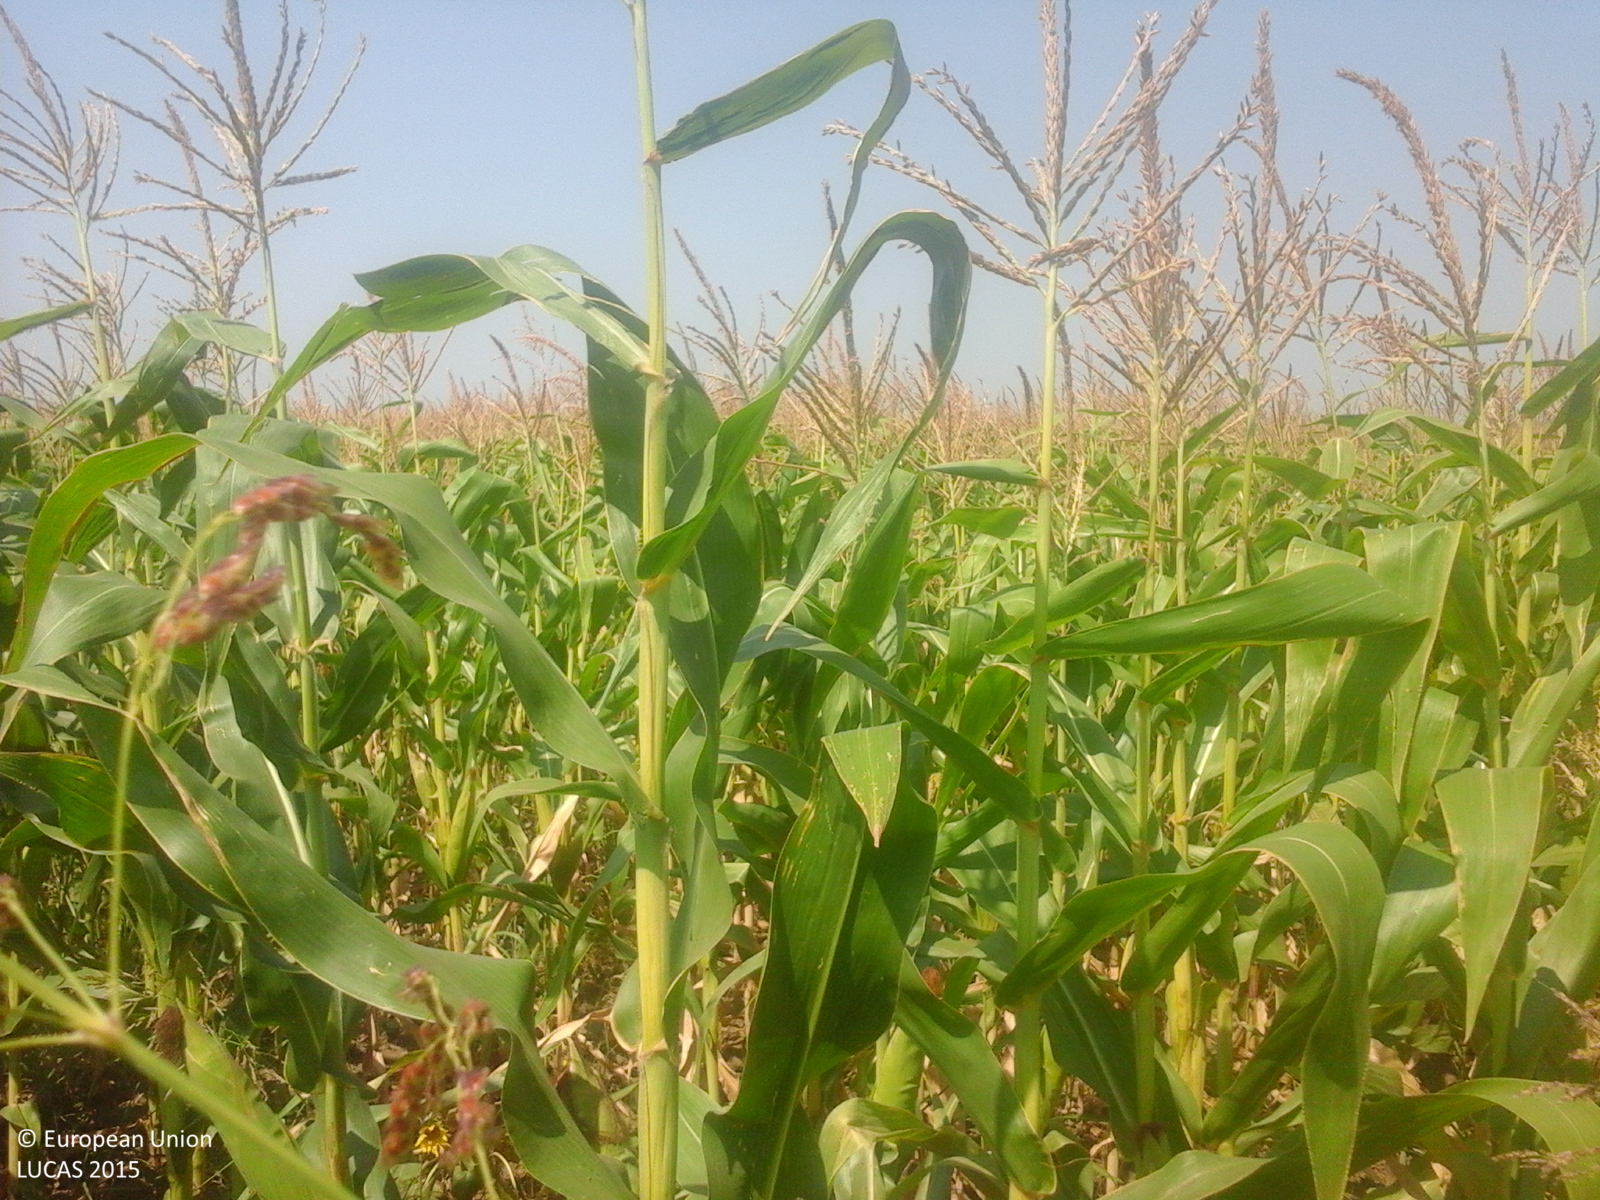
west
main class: Cropland
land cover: Maize
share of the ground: > 75 %
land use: Agriculture (excluding fallow land and kitchen gardens)
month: August
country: RO
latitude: 45.1814
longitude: 27.7582
